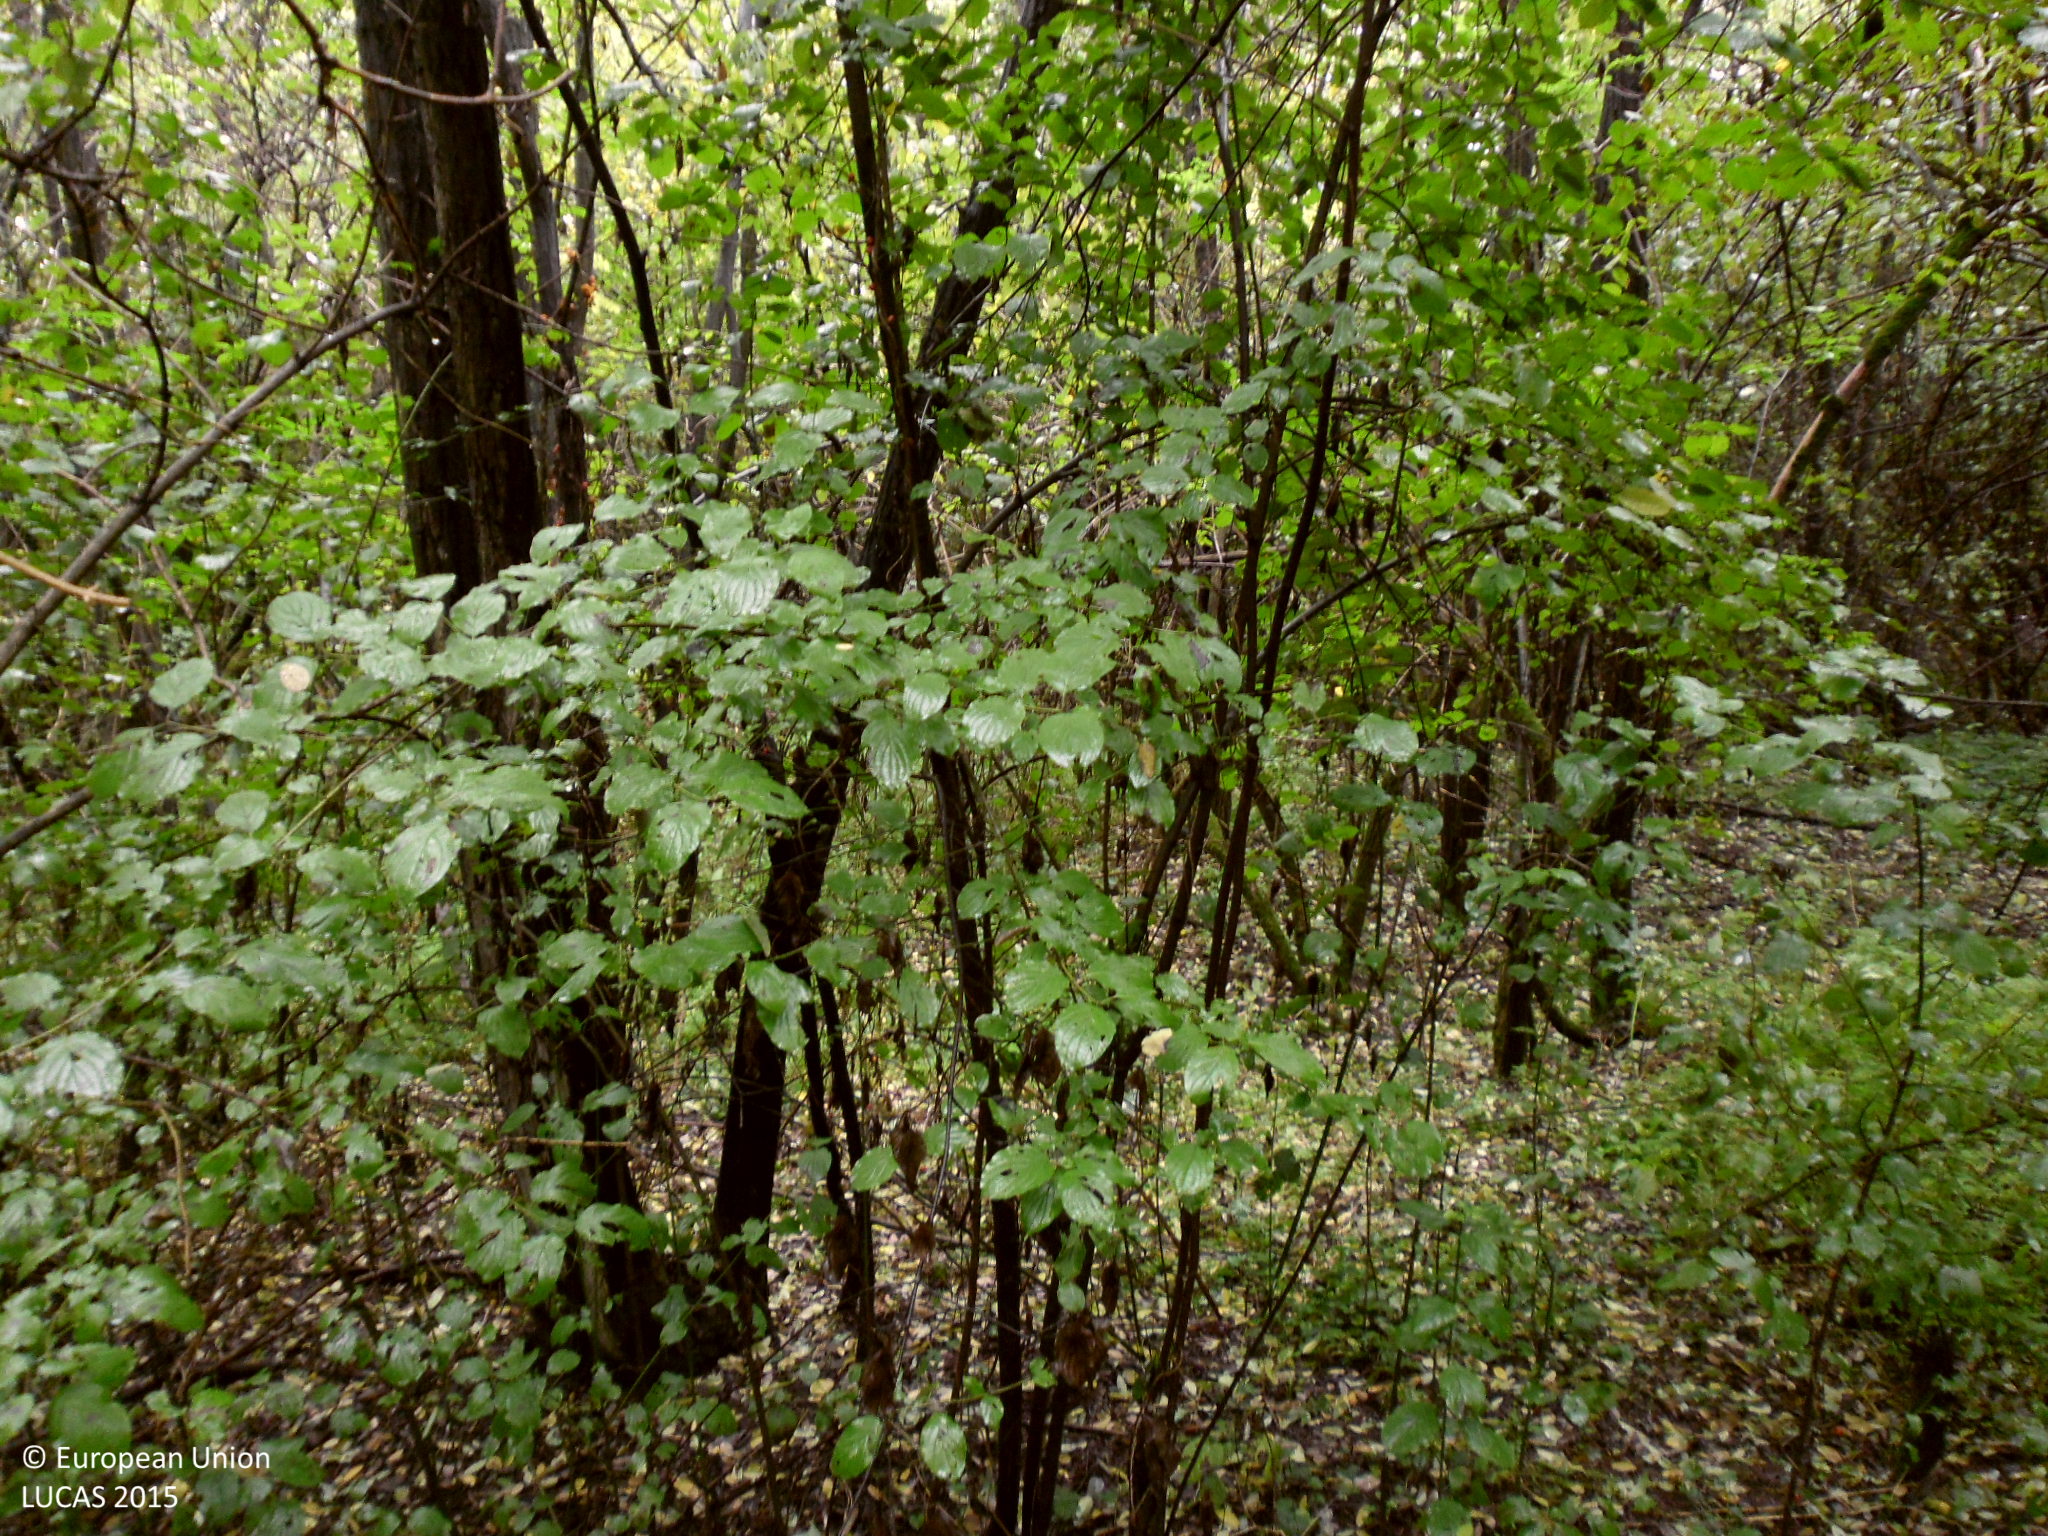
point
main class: Woodland
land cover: Broadleaved woodland
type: mesophytic deciduous forest
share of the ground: > 75 %
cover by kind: broadleaved forest trees 100 %
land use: Forestry
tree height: > 5 m
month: October
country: BG
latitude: 43.9166
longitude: 22.5249
